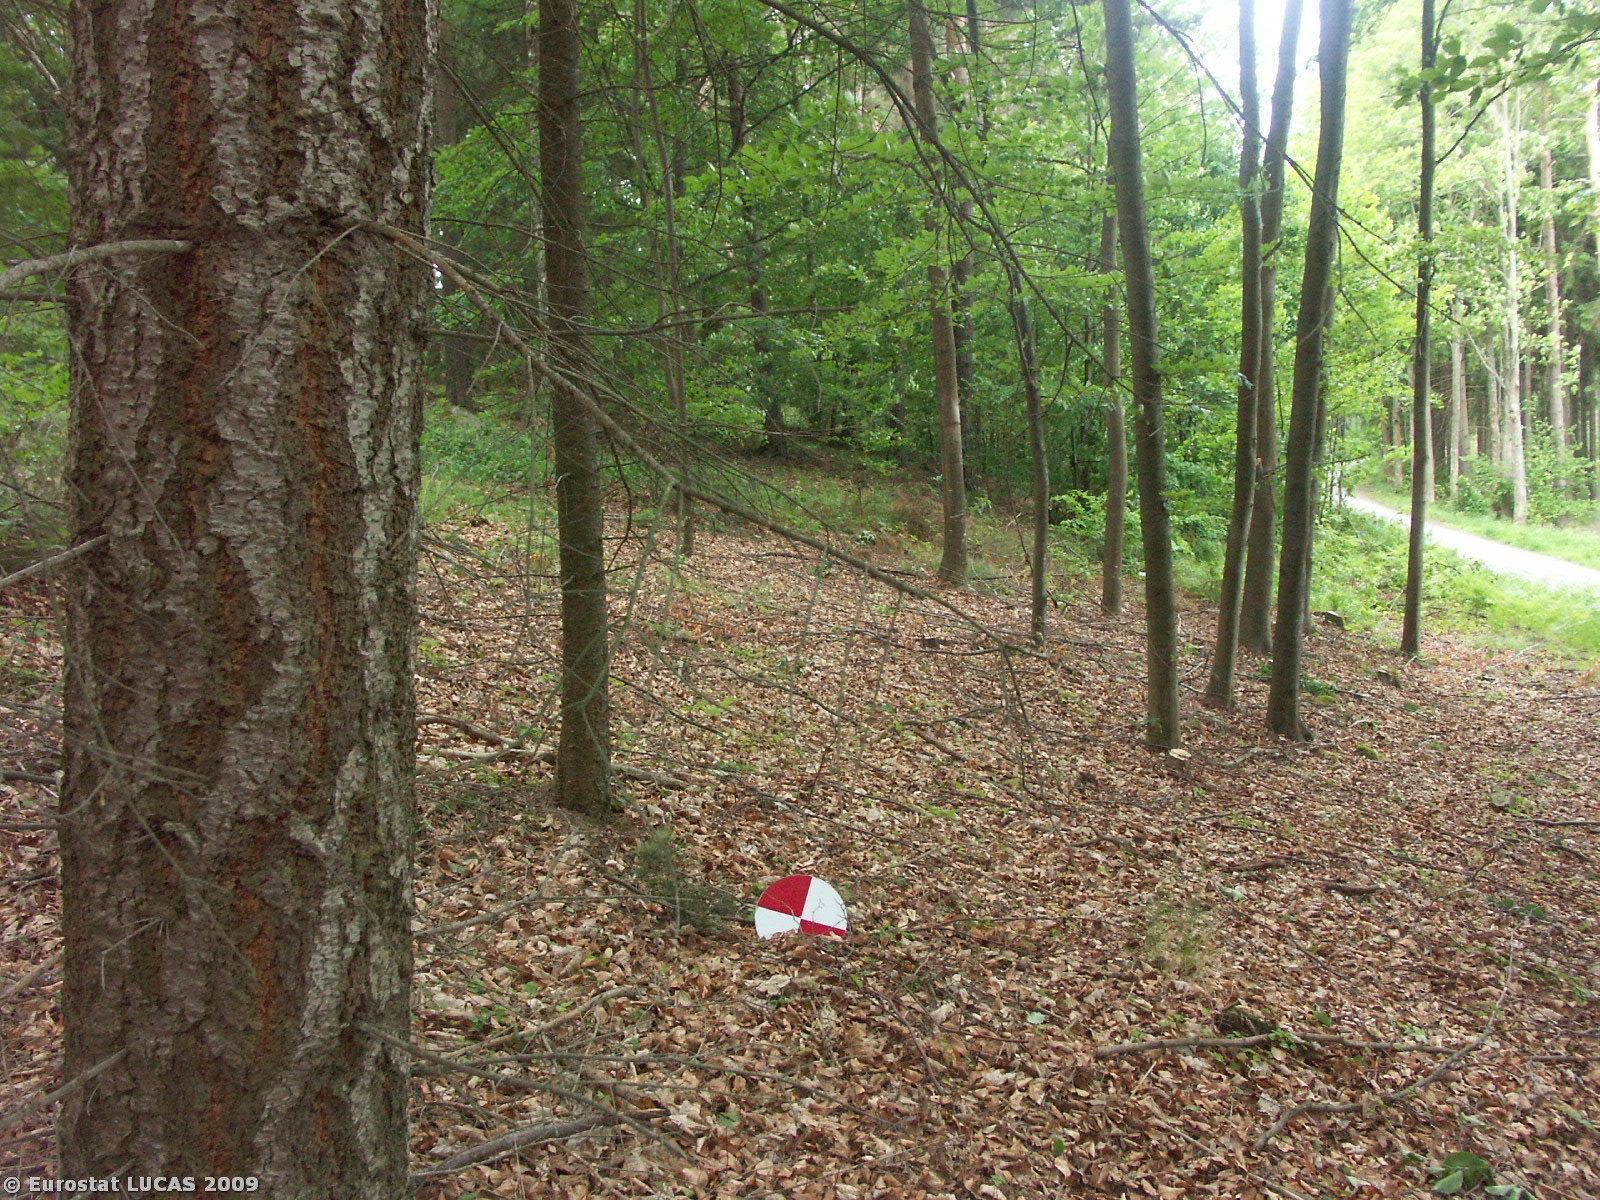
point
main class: Woodland
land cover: Mixed woodland
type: hemiboreal forest and nemoral coniferous forest and mixed broadleaved-coniferous forest
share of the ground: > 75 %
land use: Forestry
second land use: Nature reserves
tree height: > 5 m
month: May
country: CZ
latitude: 48.8427
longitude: 14.2928
